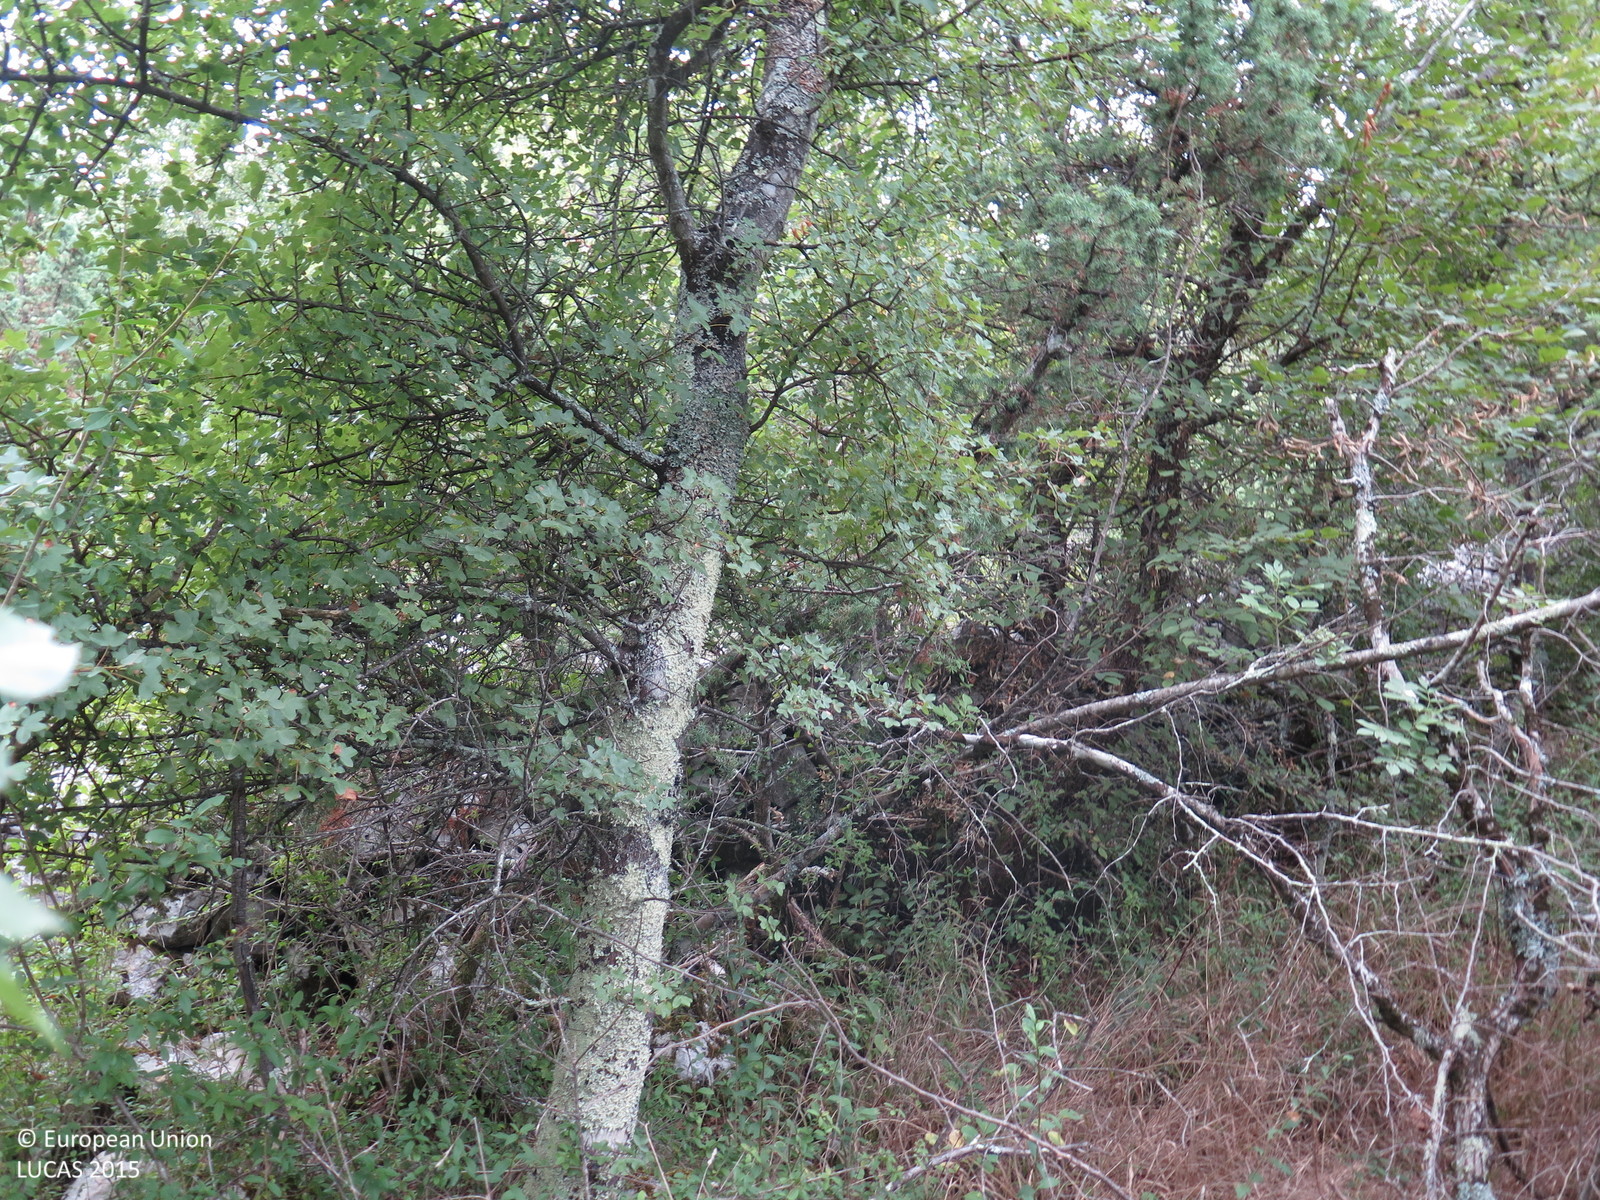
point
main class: Woodland
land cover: Broadleaved woodland
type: thermophilous deciduous forest
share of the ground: > 75 %
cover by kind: broadleaved forest trees 90 %, shrubs 5 %, herbaceous plants 5 %
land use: Semi-natural and natural areas not in use
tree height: > 5 m
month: August
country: HR
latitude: 45.1330
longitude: 14.6102
